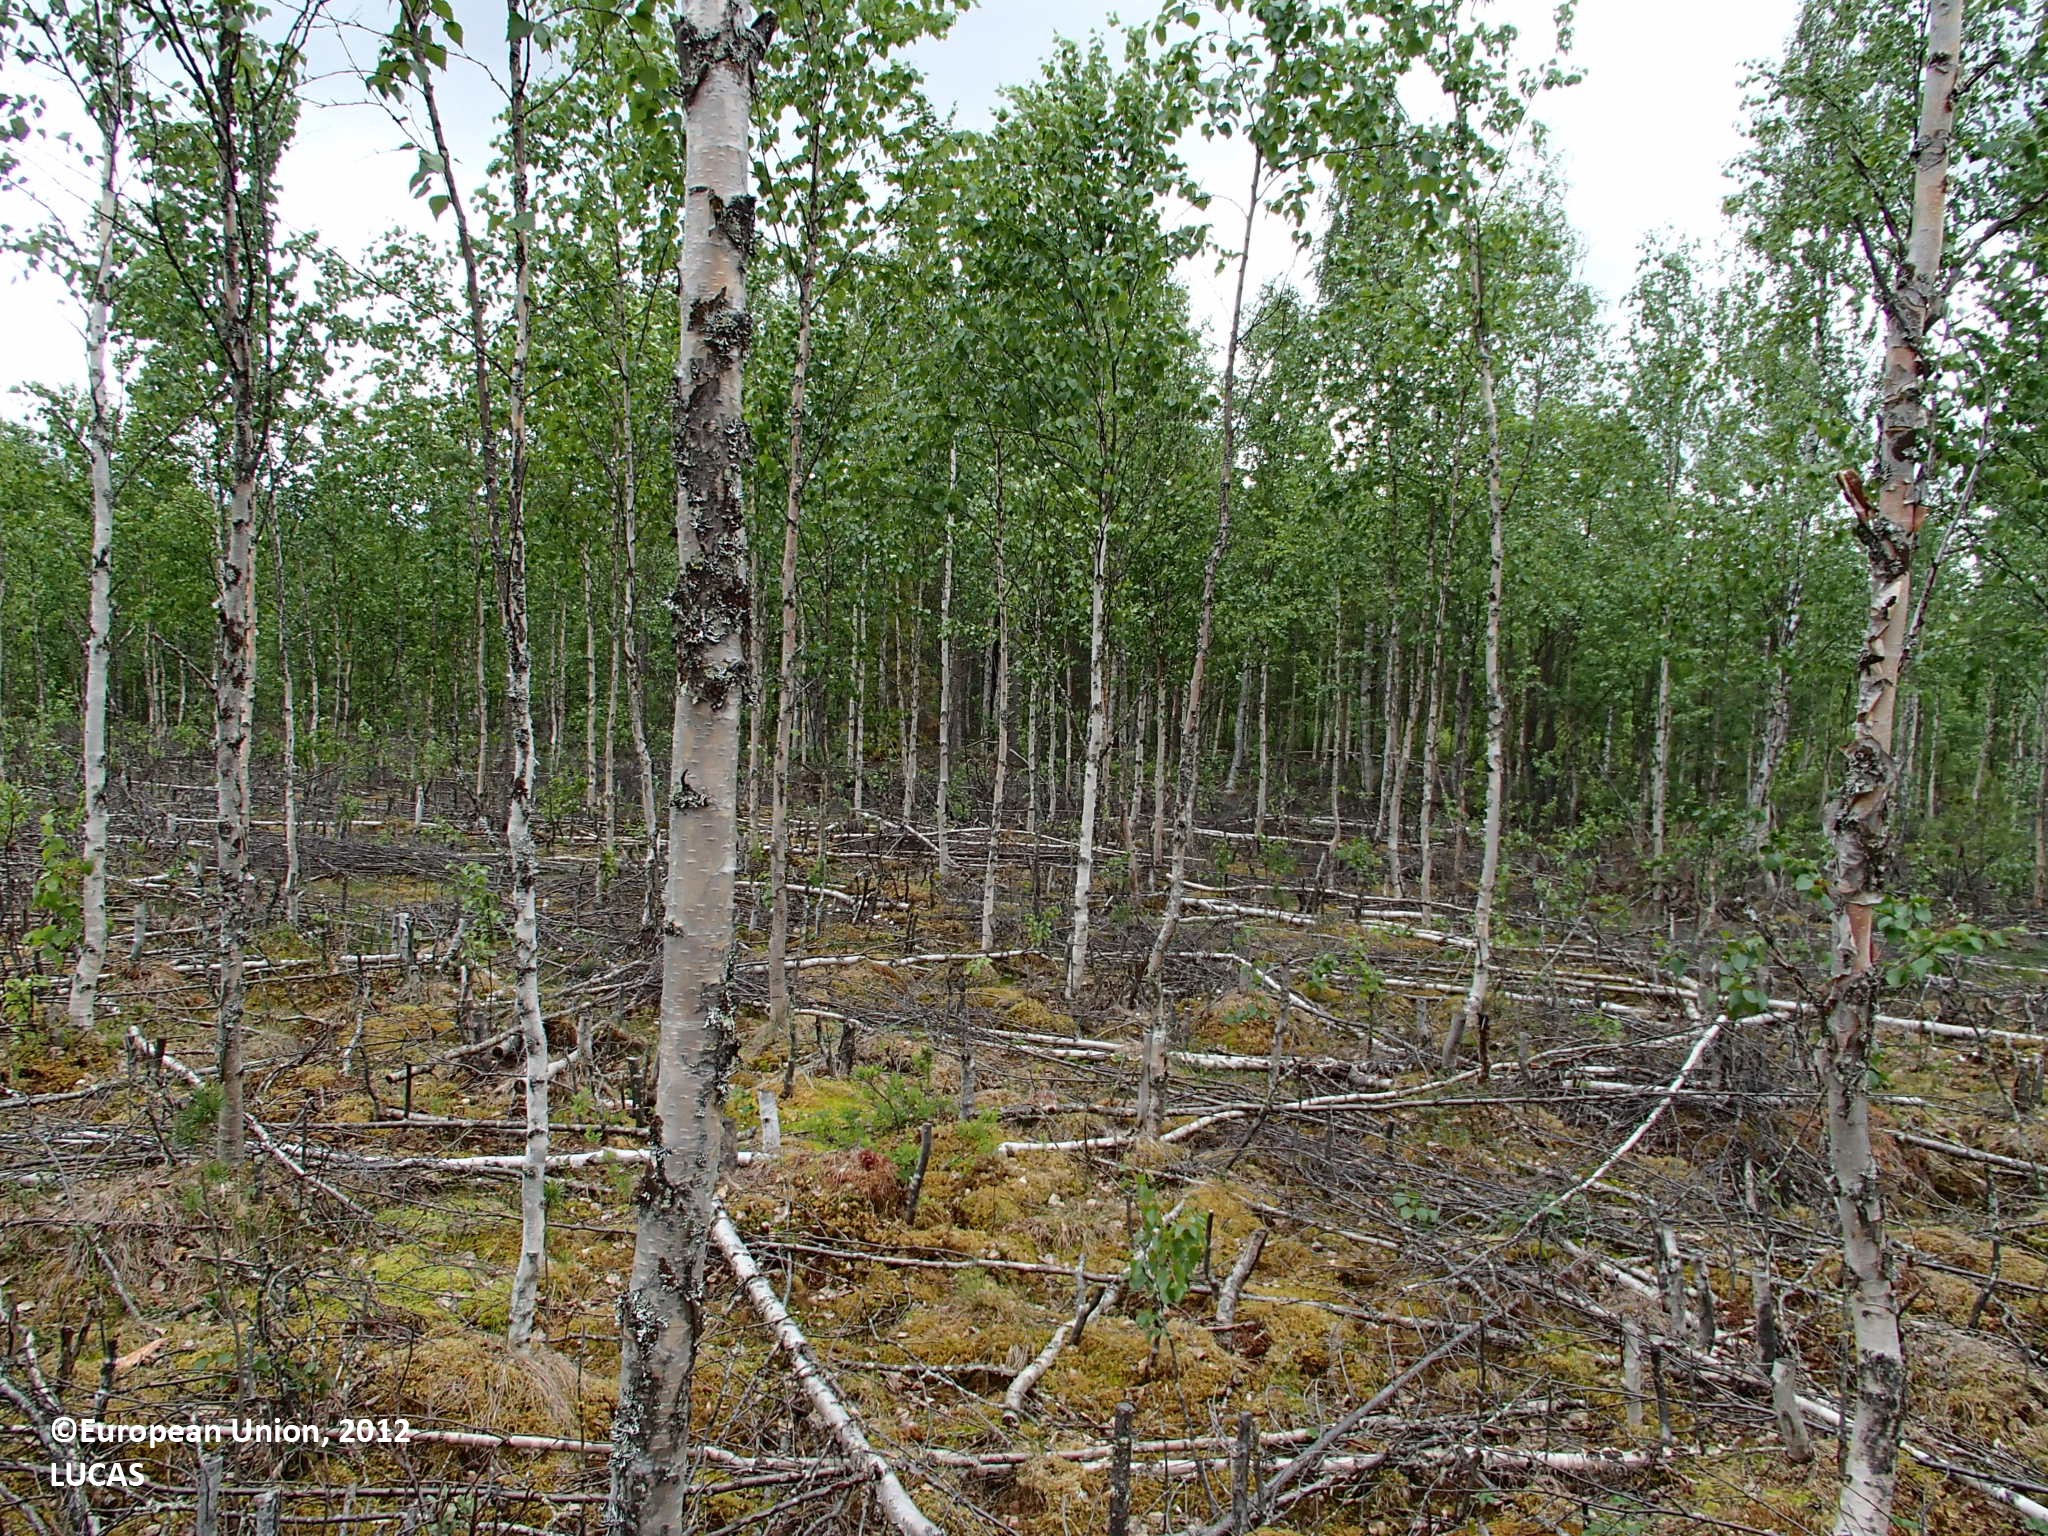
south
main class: Woodland
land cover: Pine dominated mixed woodland
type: boreal forest
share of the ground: 25 - 50 %
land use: Forestry
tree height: > 5 m
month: June
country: FI
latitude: 66.4955
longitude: 27.2517
